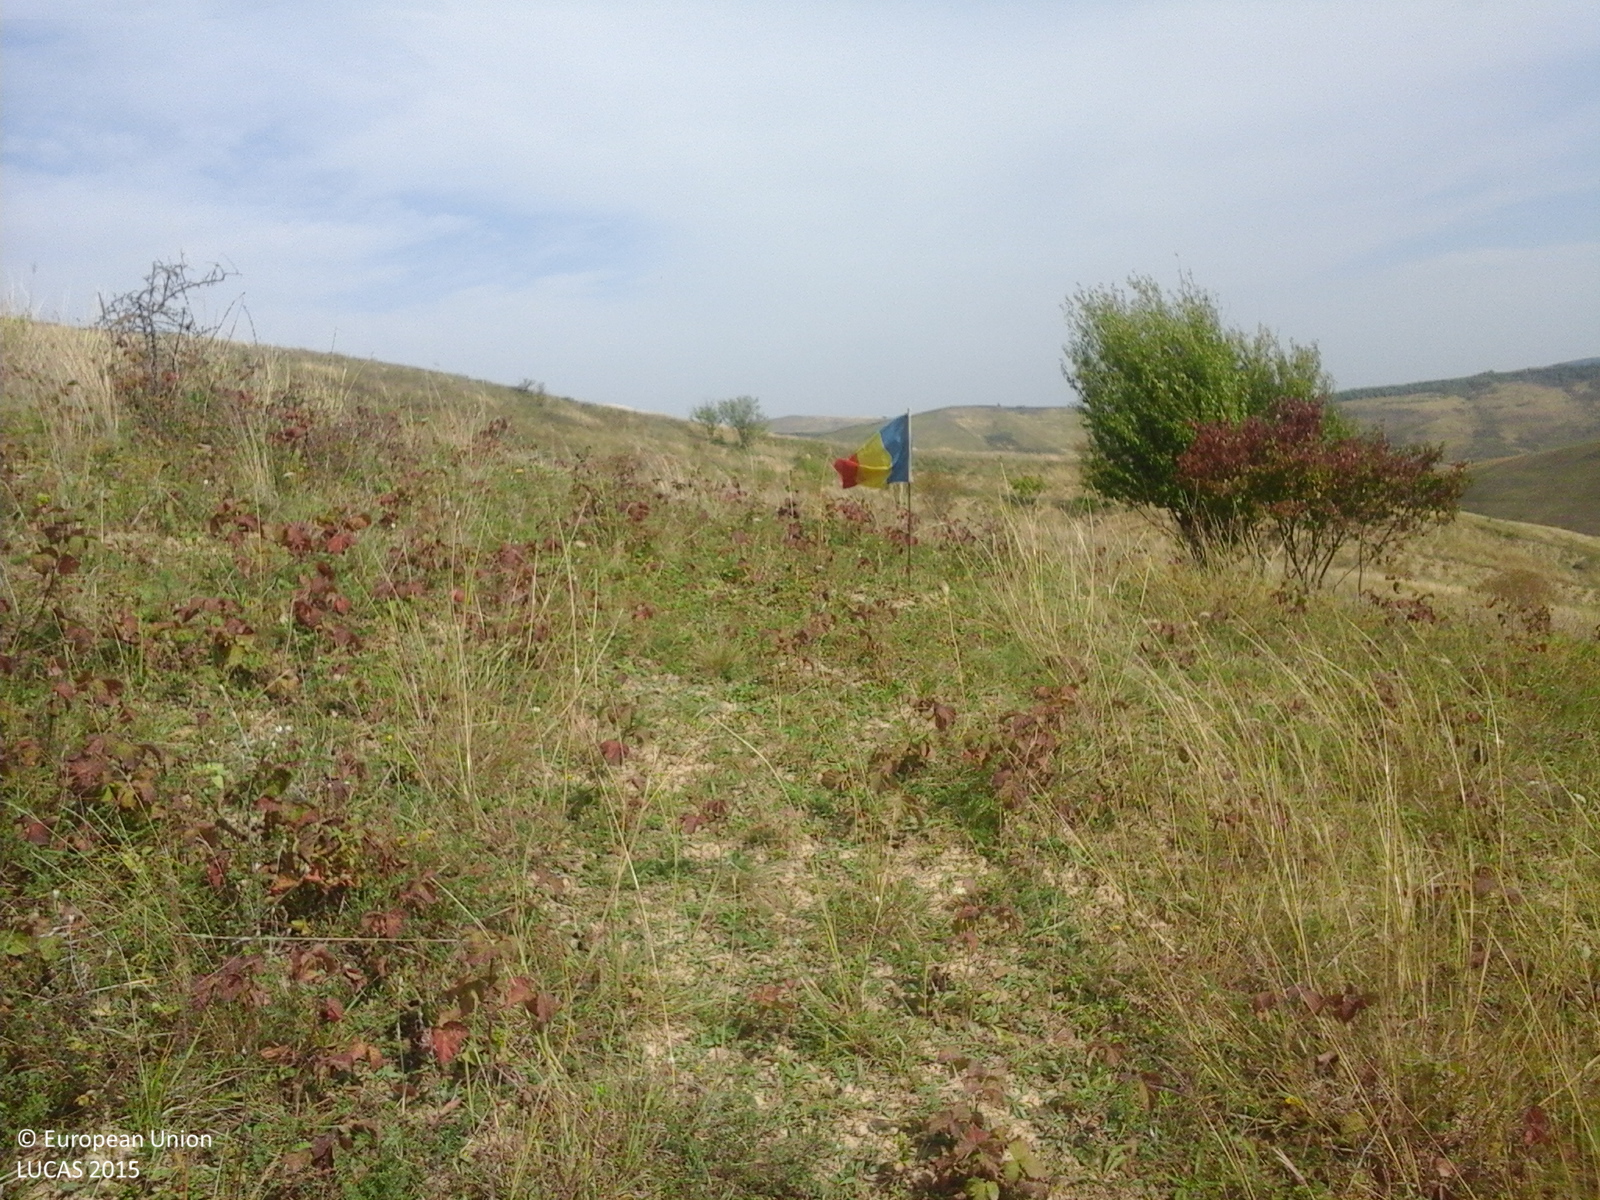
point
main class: Grassland
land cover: Grassland with sparse tree/shrub cover
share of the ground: > 75 %
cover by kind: herbaceous plants 95 %, broadleaved forest trees 5 %
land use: Agriculture (excluding fallow land and kitchen gardens)
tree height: < 5 m
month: September
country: RO
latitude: 46.7406
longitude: 23.8575
